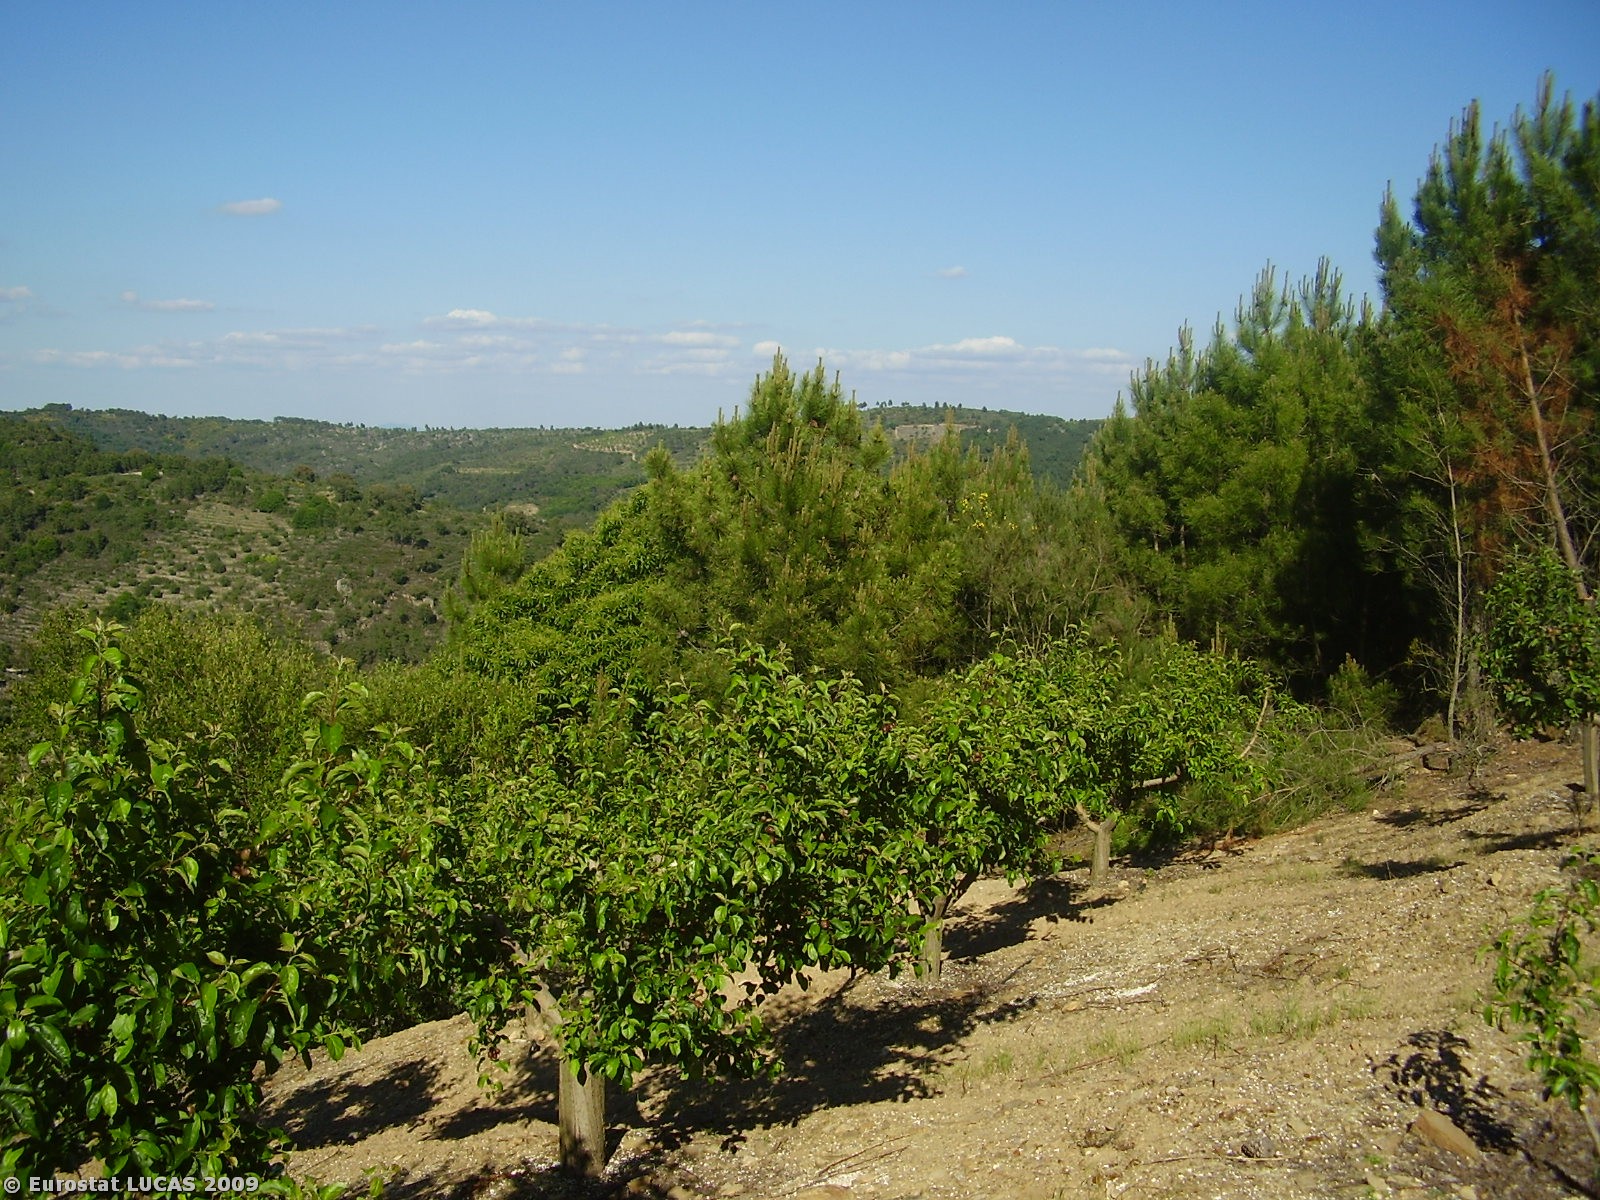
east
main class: Cropland
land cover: Apple fruit
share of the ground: 10 - 25 %
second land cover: Spontaneously vegetated surfaces
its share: < 10 %
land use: Agriculture (excluding fallow land and kitchen gardens)
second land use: Unused
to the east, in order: Apple fruit; Spontaneously vegetated surfaces; Mixed woodland; Abandoned hedges; Tracks; Shrubland with sparse tree cover; Dry stone walls; Shrubland with sparse tree cover; Coniferous woodland
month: May
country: PT
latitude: 41.2150
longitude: -7.2561
